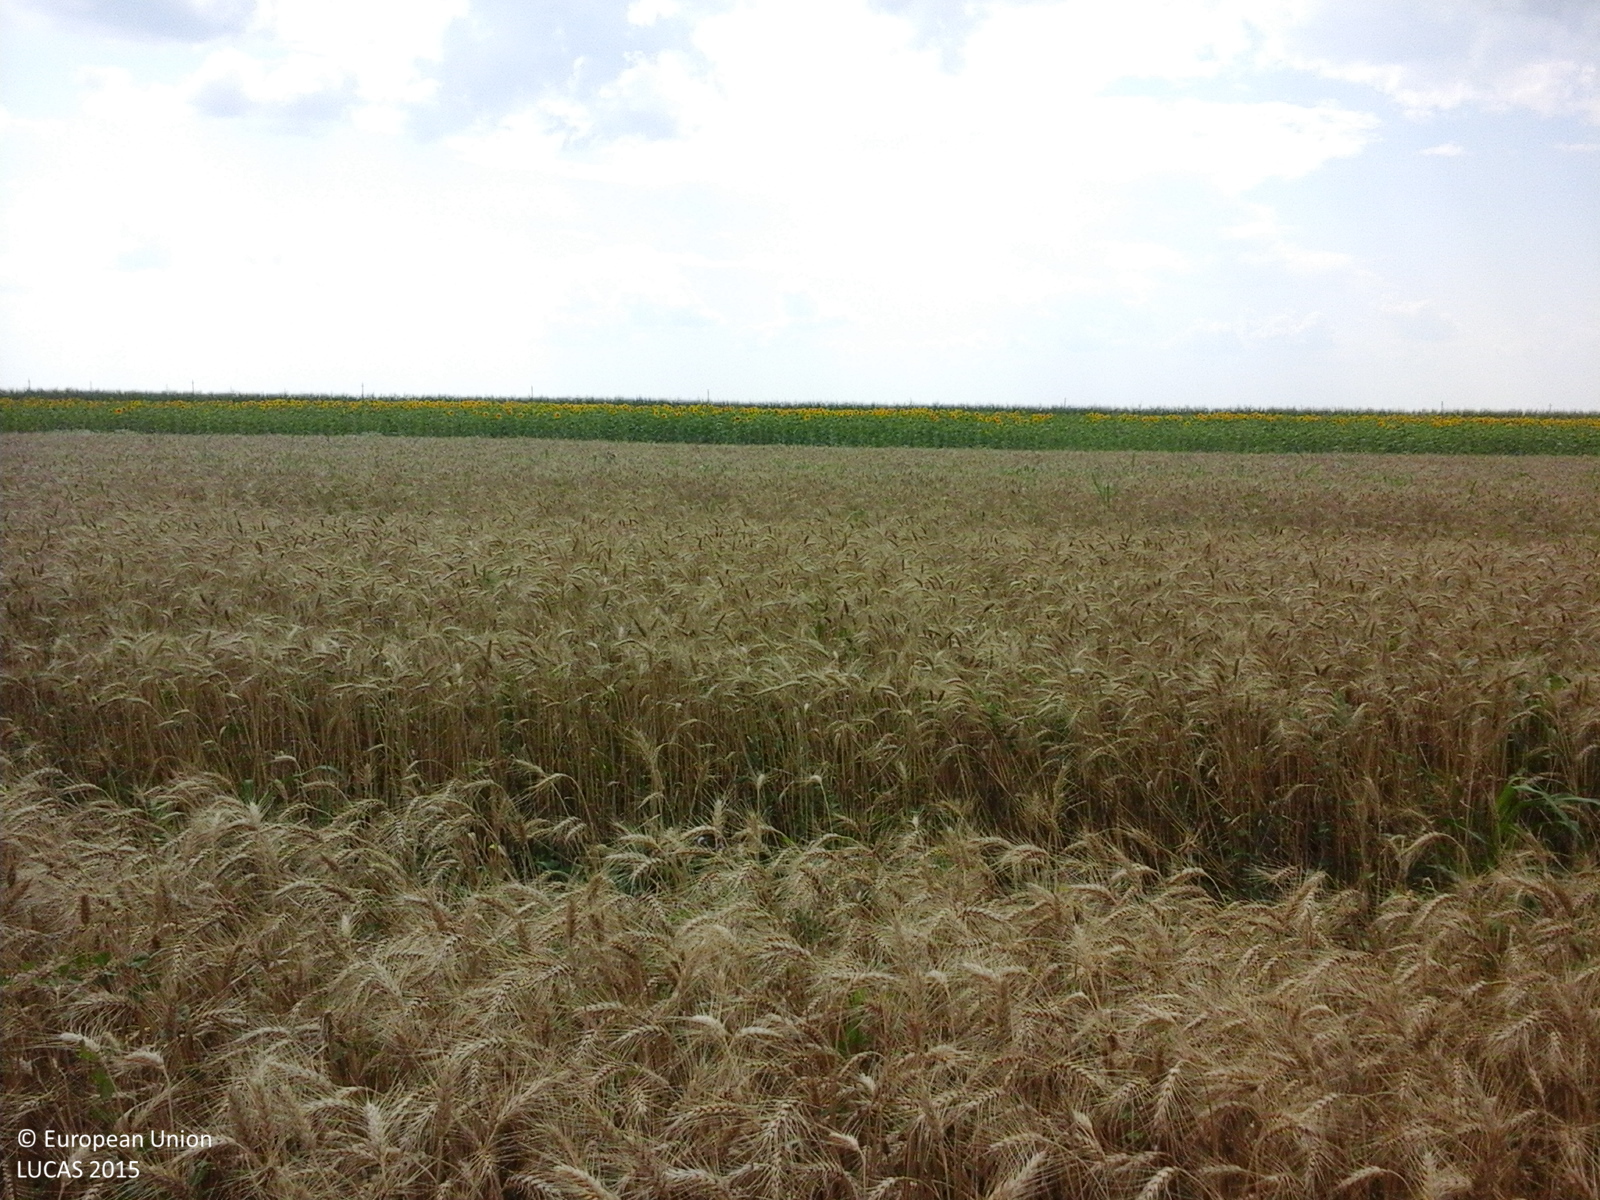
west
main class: Cropland
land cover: Common wheat
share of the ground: > 75 %
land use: Agriculture (excluding fallow land and kitchen gardens)
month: July
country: RO
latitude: 43.9190
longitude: 25.5677
